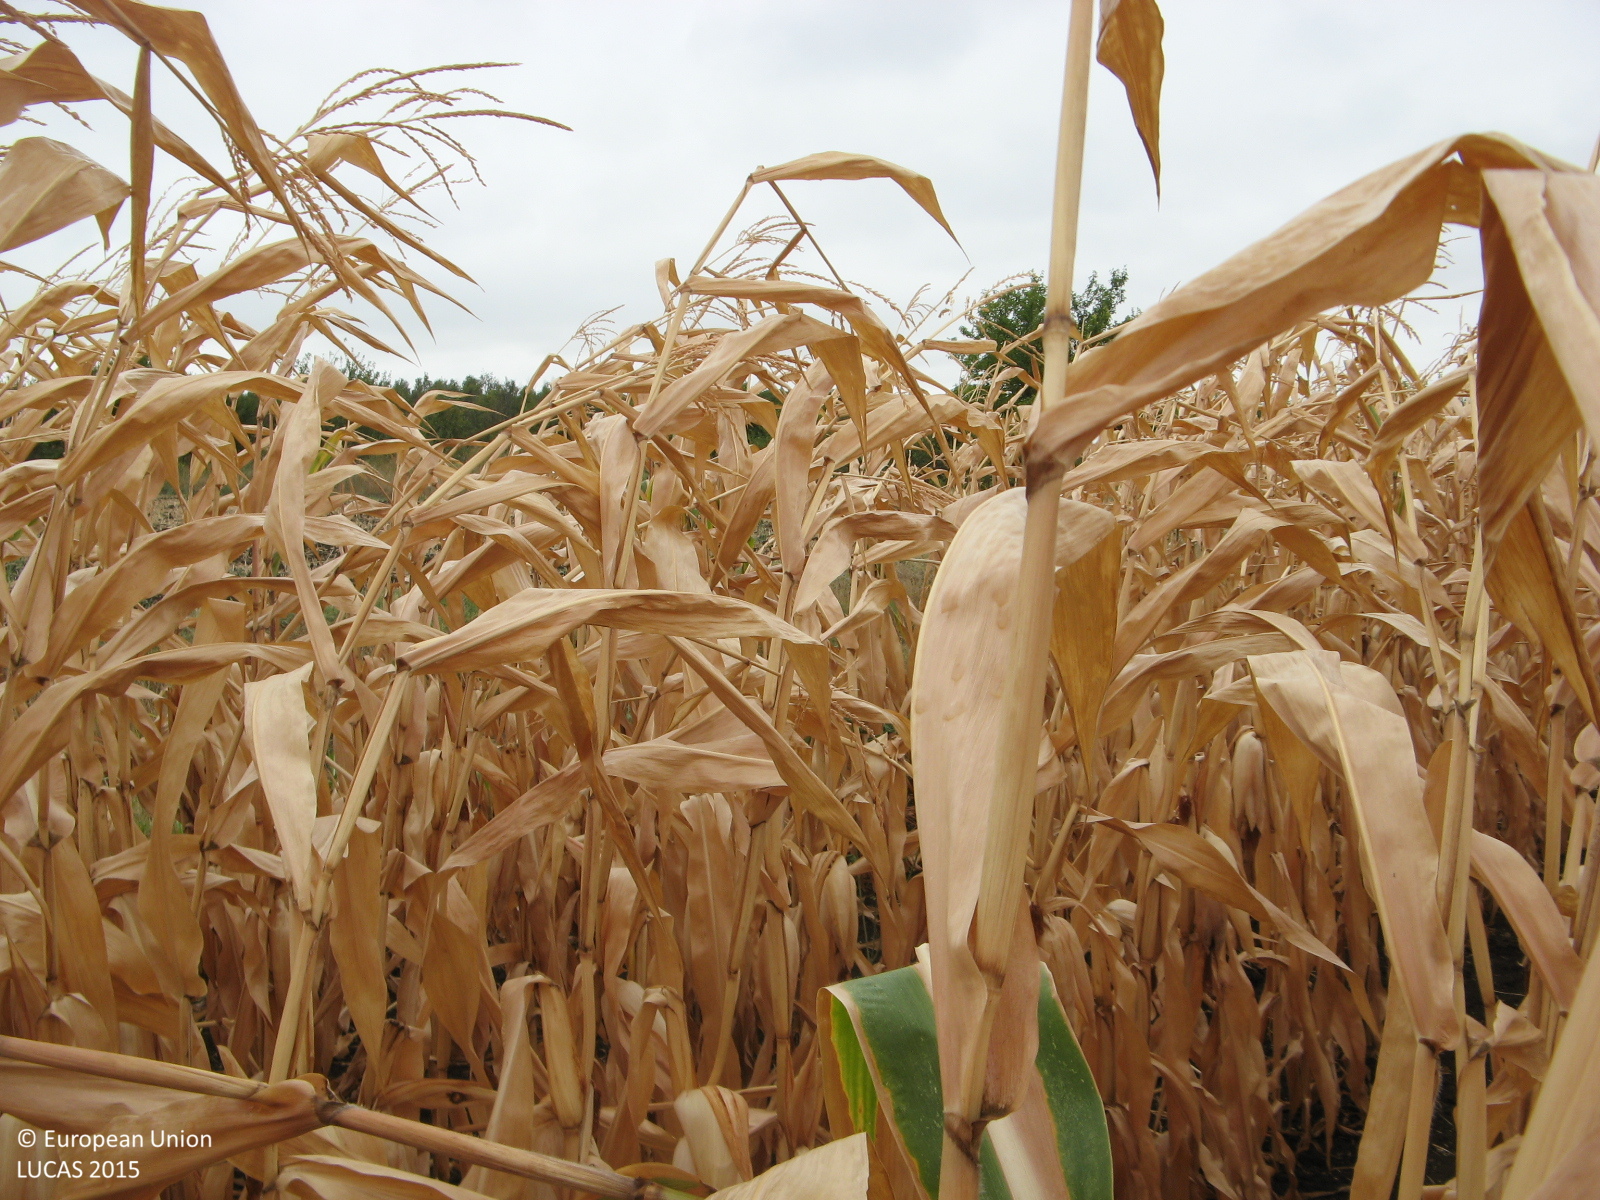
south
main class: Cropland
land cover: Maize
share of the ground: > 75 %
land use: Agriculture (excluding fallow land and kitchen gardens)
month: August
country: BG
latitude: 43.3769
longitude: 25.3949
